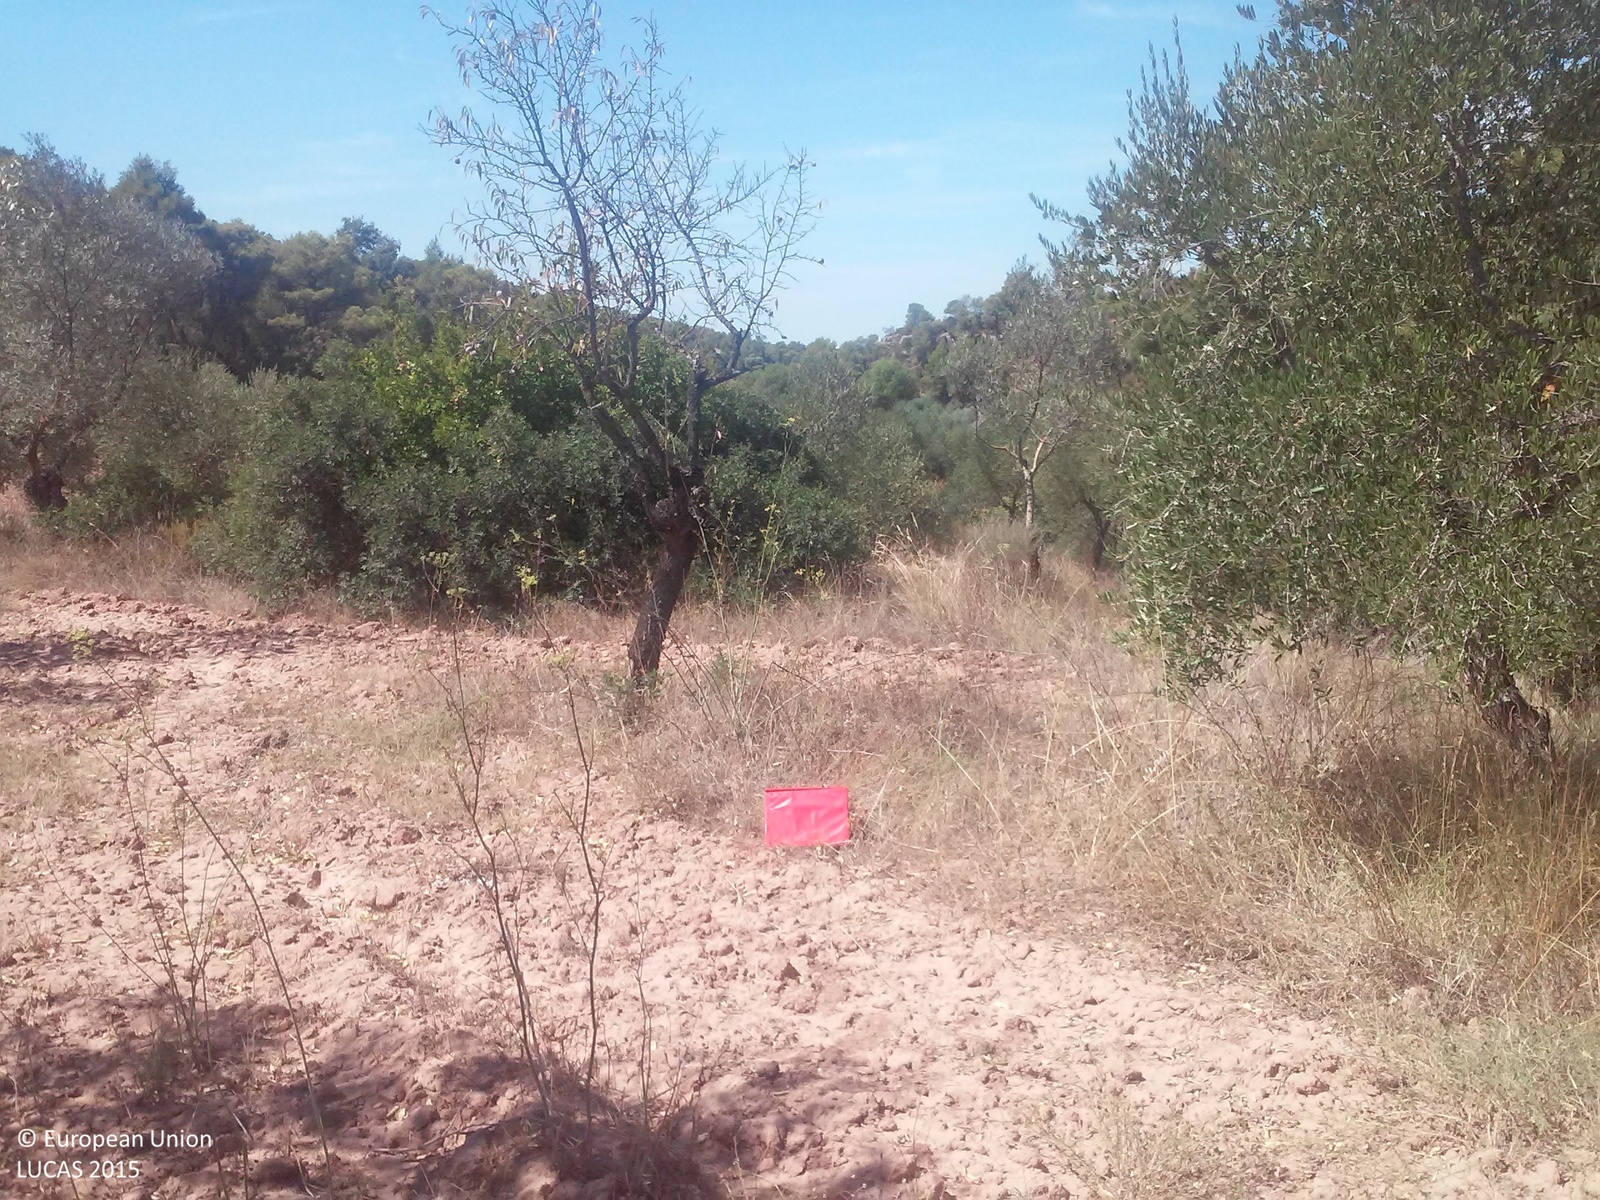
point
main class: Cropland
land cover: Olive groves
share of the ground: < 10 %
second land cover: Nuts trees
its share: < 10 %
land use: Agriculture (excluding fallow land and kitchen gardens)
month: August
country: ES
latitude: 41.3241
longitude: 0.5874
